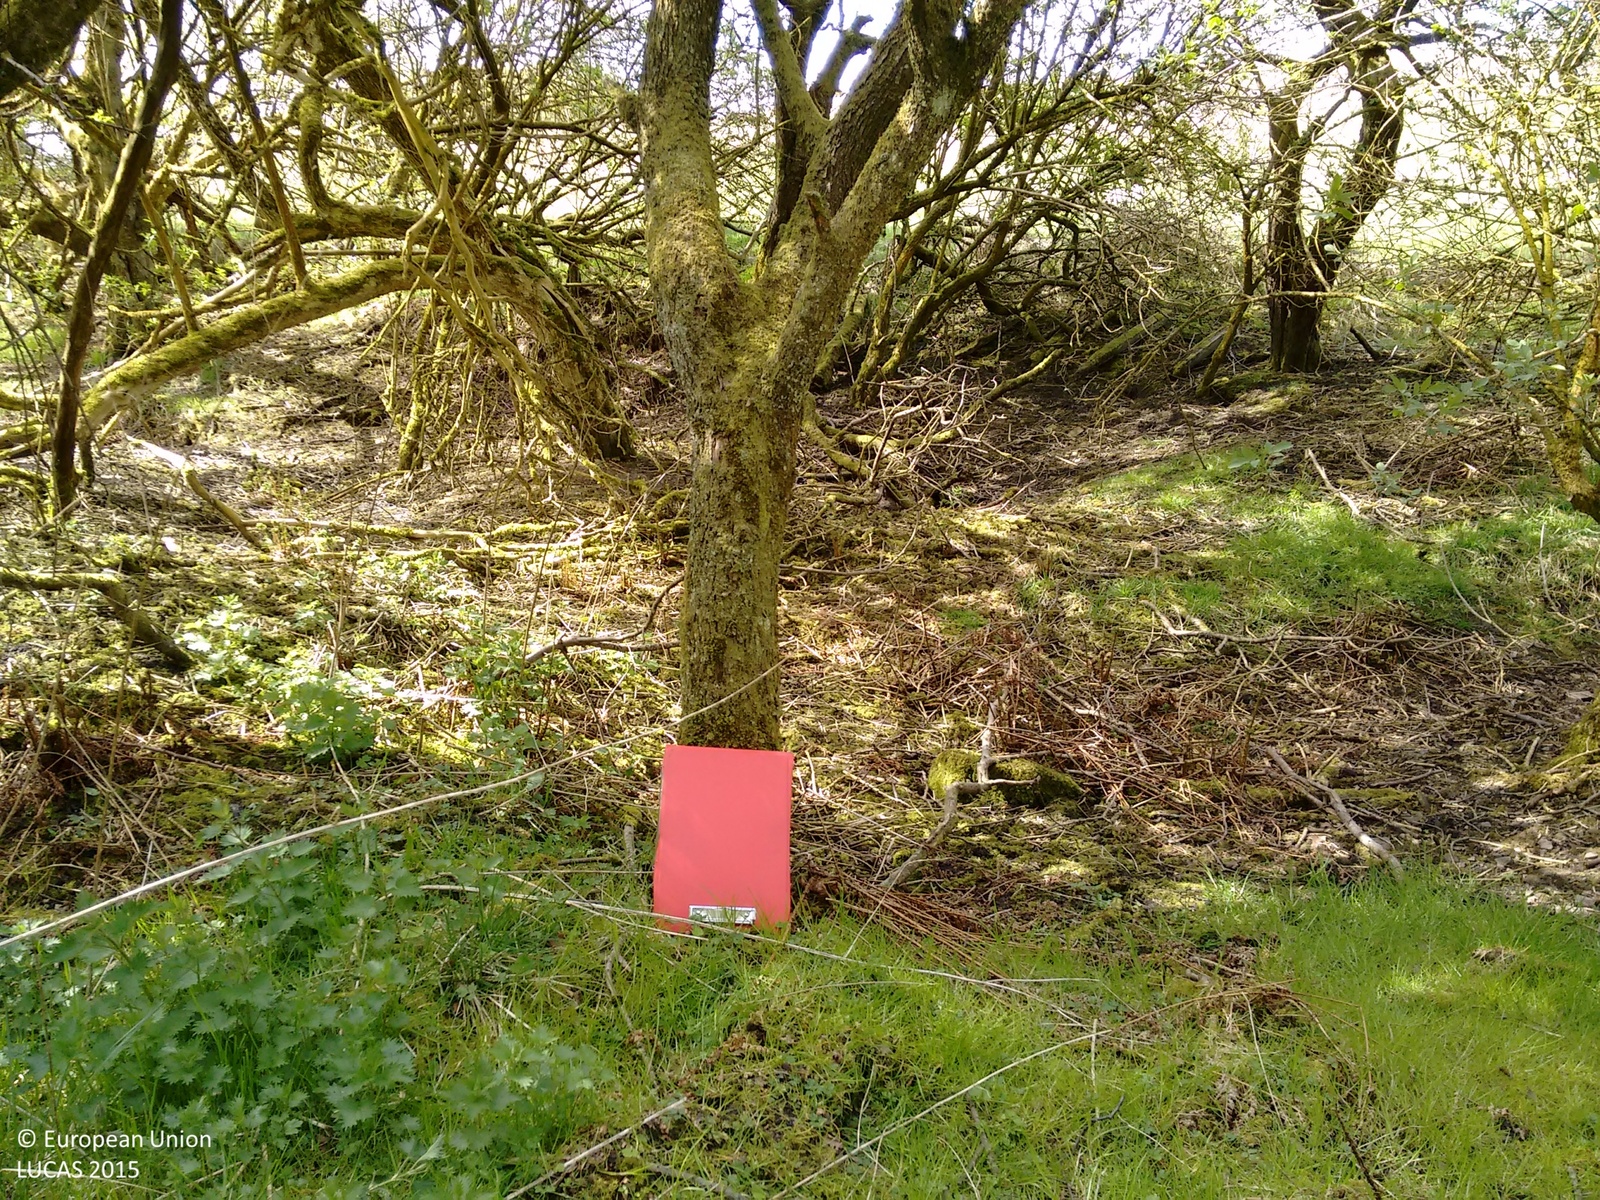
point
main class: Woodland
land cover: Broadleaved woodland
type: exotic forest
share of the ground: > 75 %
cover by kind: broadleaved forest trees 90 %, herbaceous plants 10 %
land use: Semi-natural and natural areas not in use
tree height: > 5 m
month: May
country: GB
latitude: 55.8922
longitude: -3.9828
